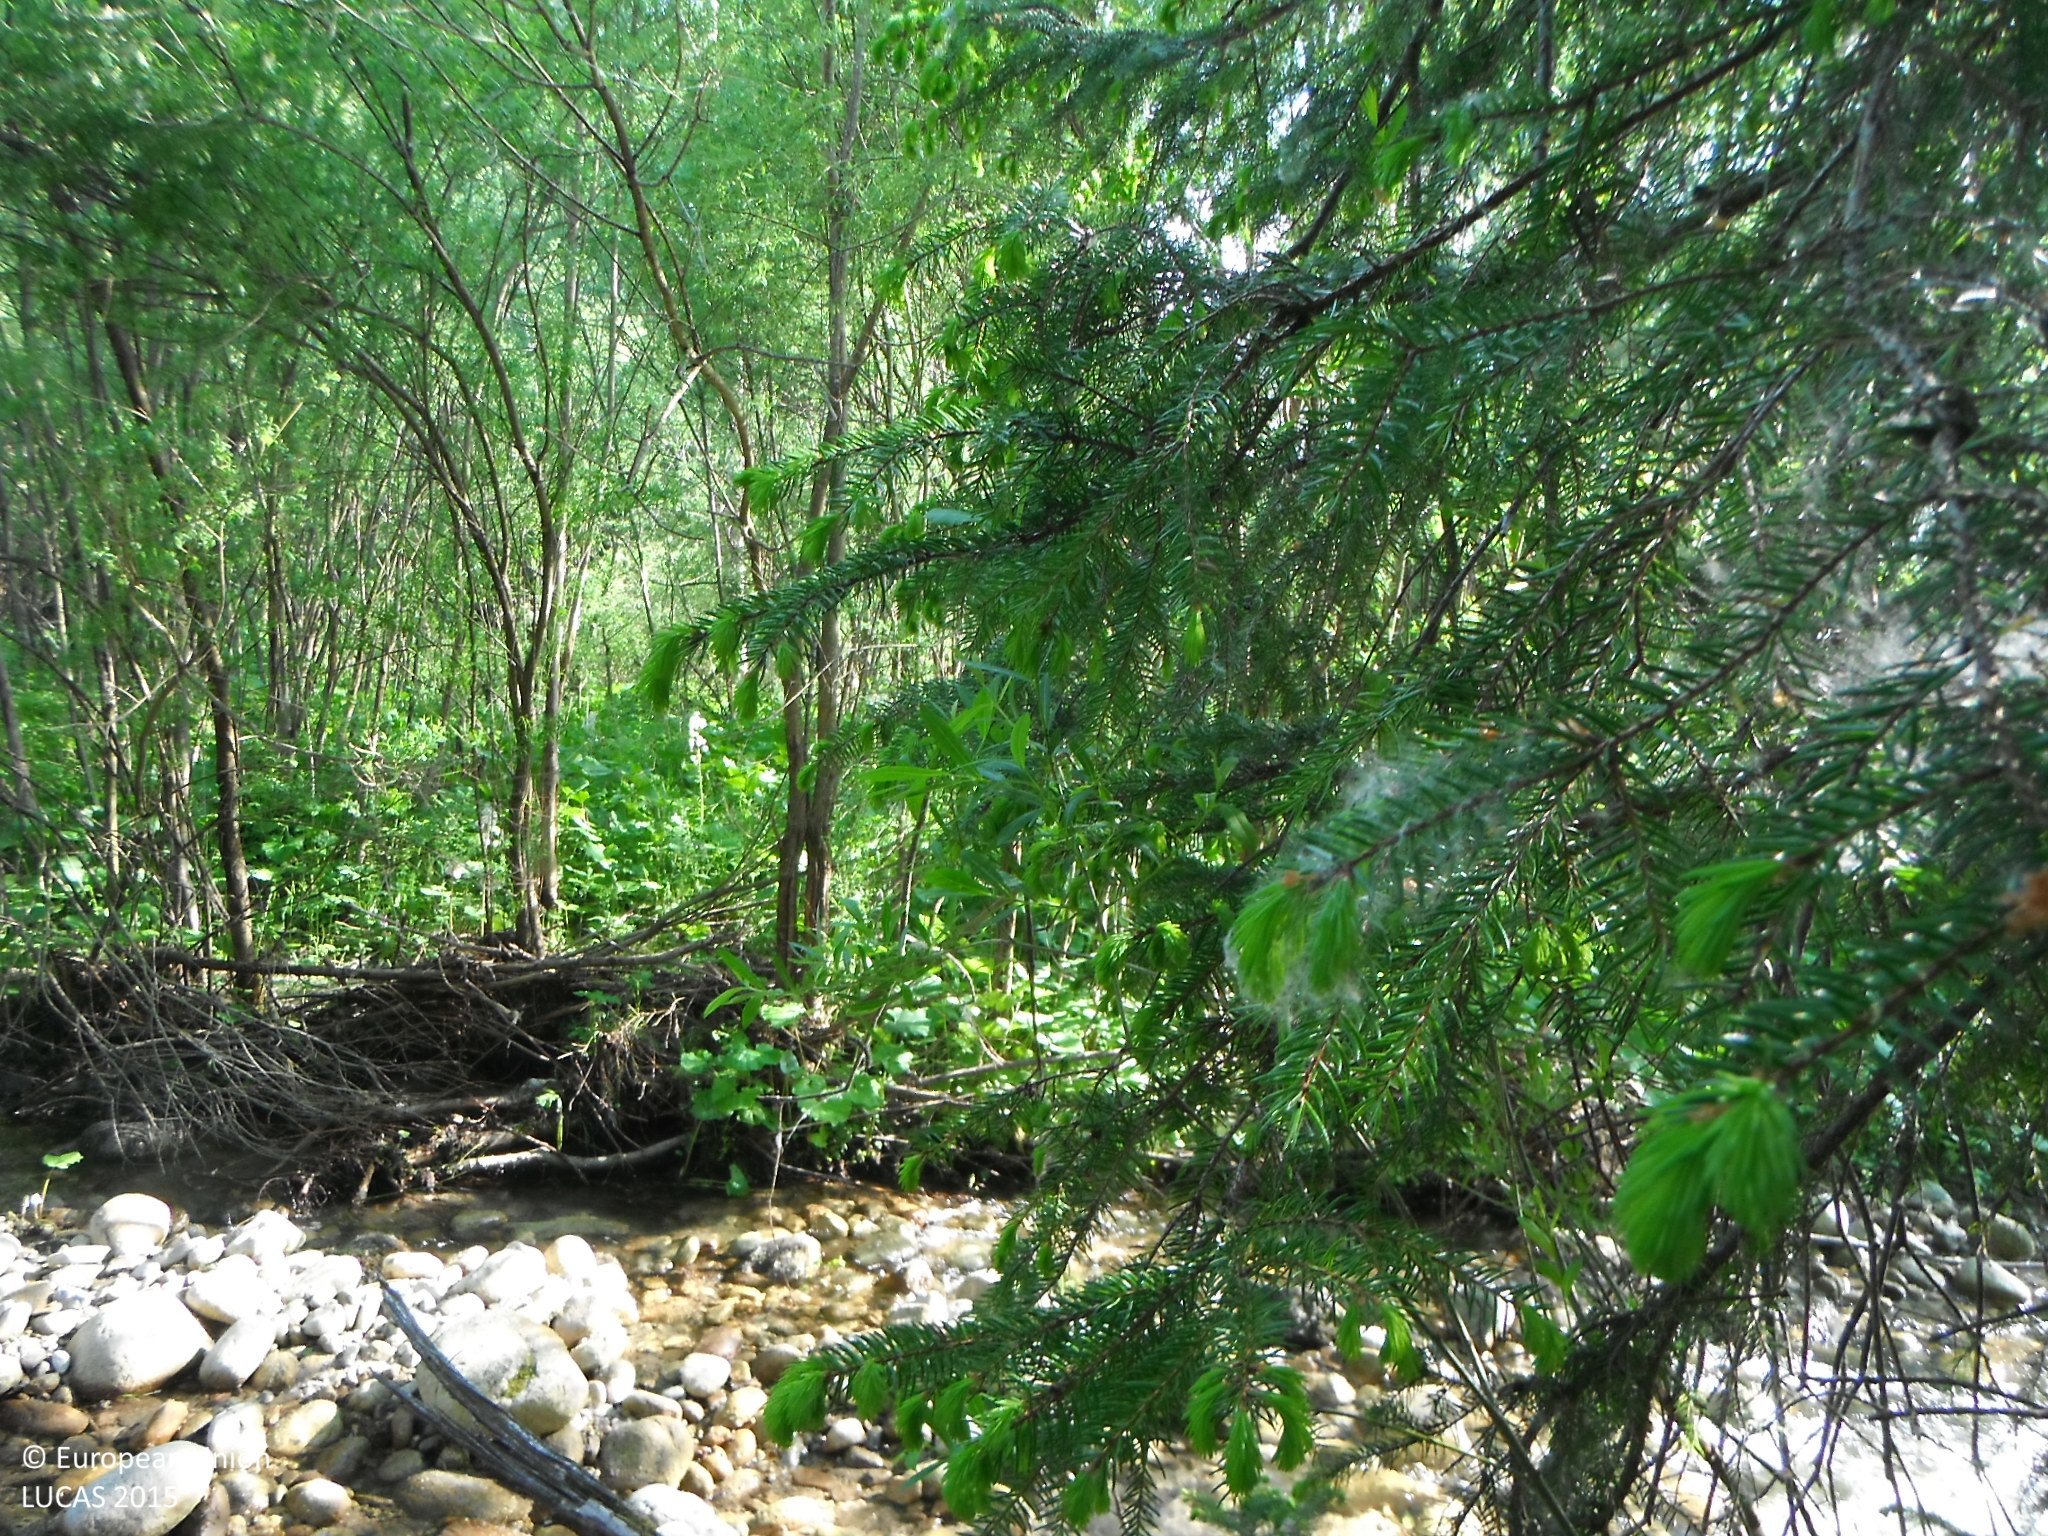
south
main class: Woodland
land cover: Broadleaved woodland
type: mesophytic deciduous forest
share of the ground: > 75 %
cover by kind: broadleaved forest trees 100 %
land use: Forestry
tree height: > 5 m
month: June
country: SK
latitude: 49.1068
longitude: 19.8234
